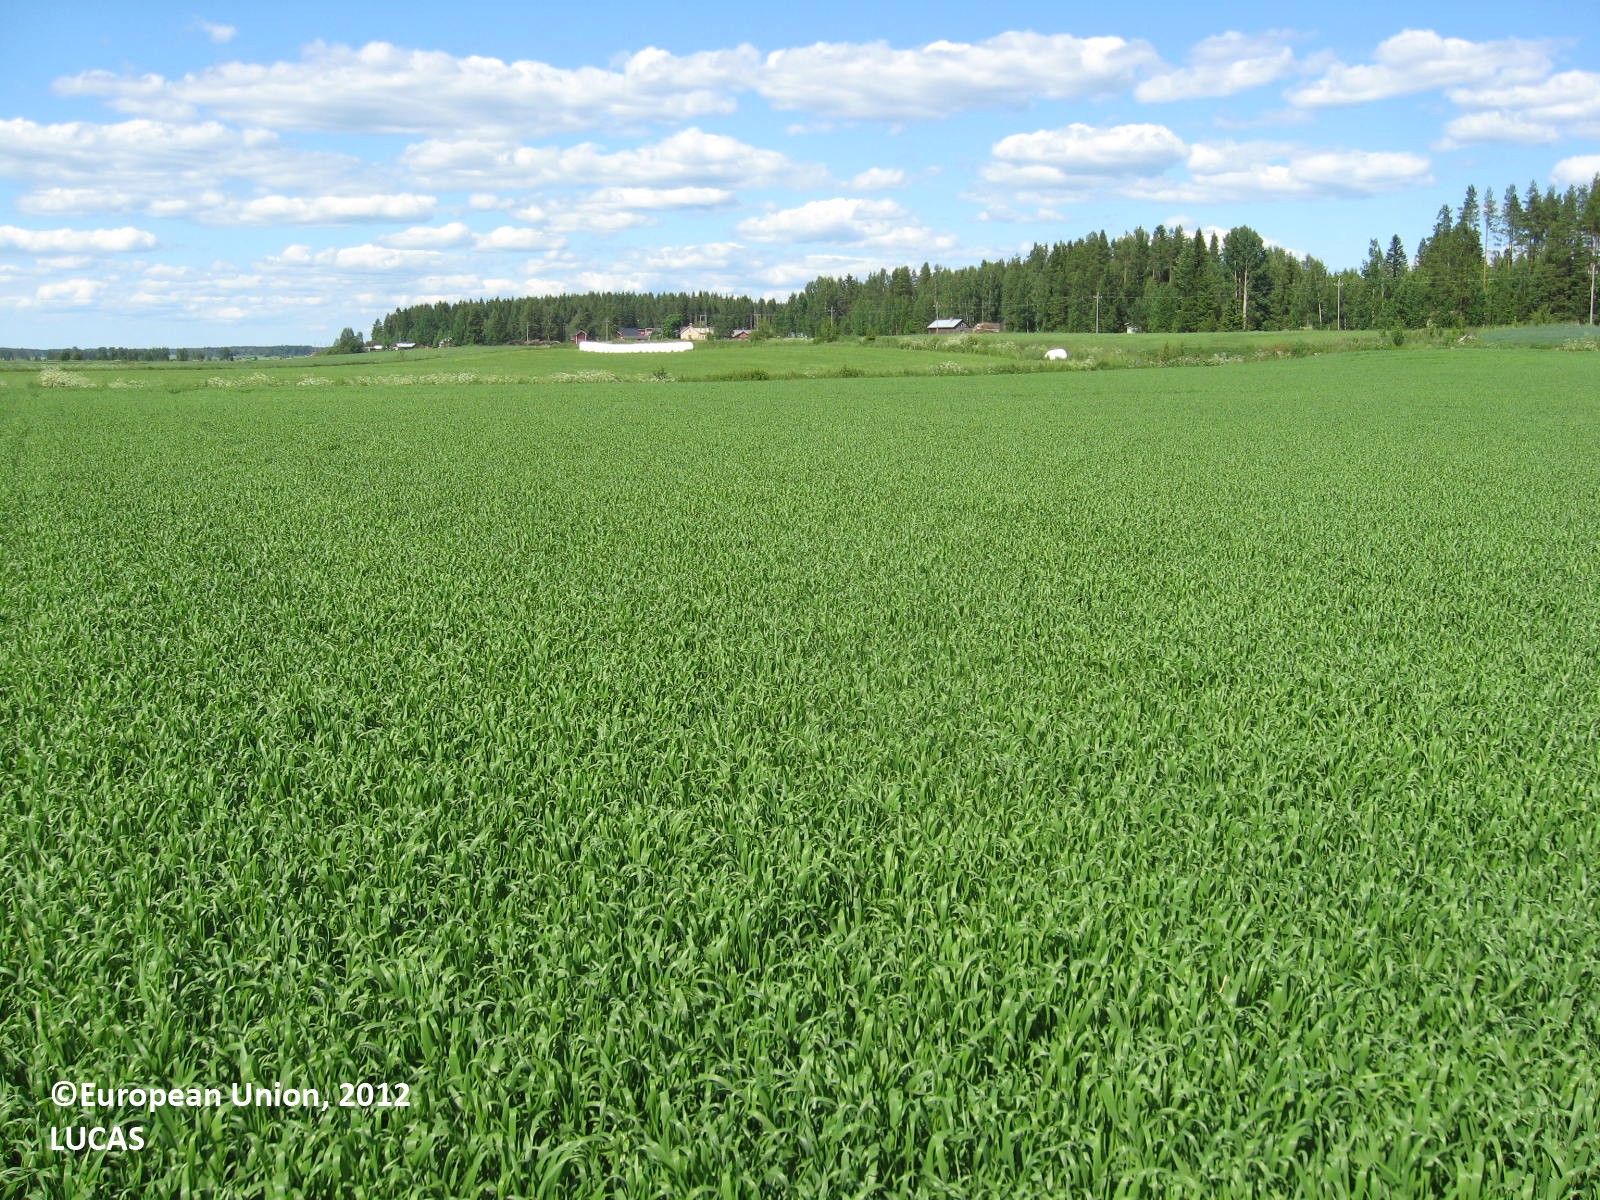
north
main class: Cropland
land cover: Barley
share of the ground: > 75 %
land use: Agriculture (excluding fallow land and kitchen gardens)
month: July
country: FI
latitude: 62.5401
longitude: 22.7919
